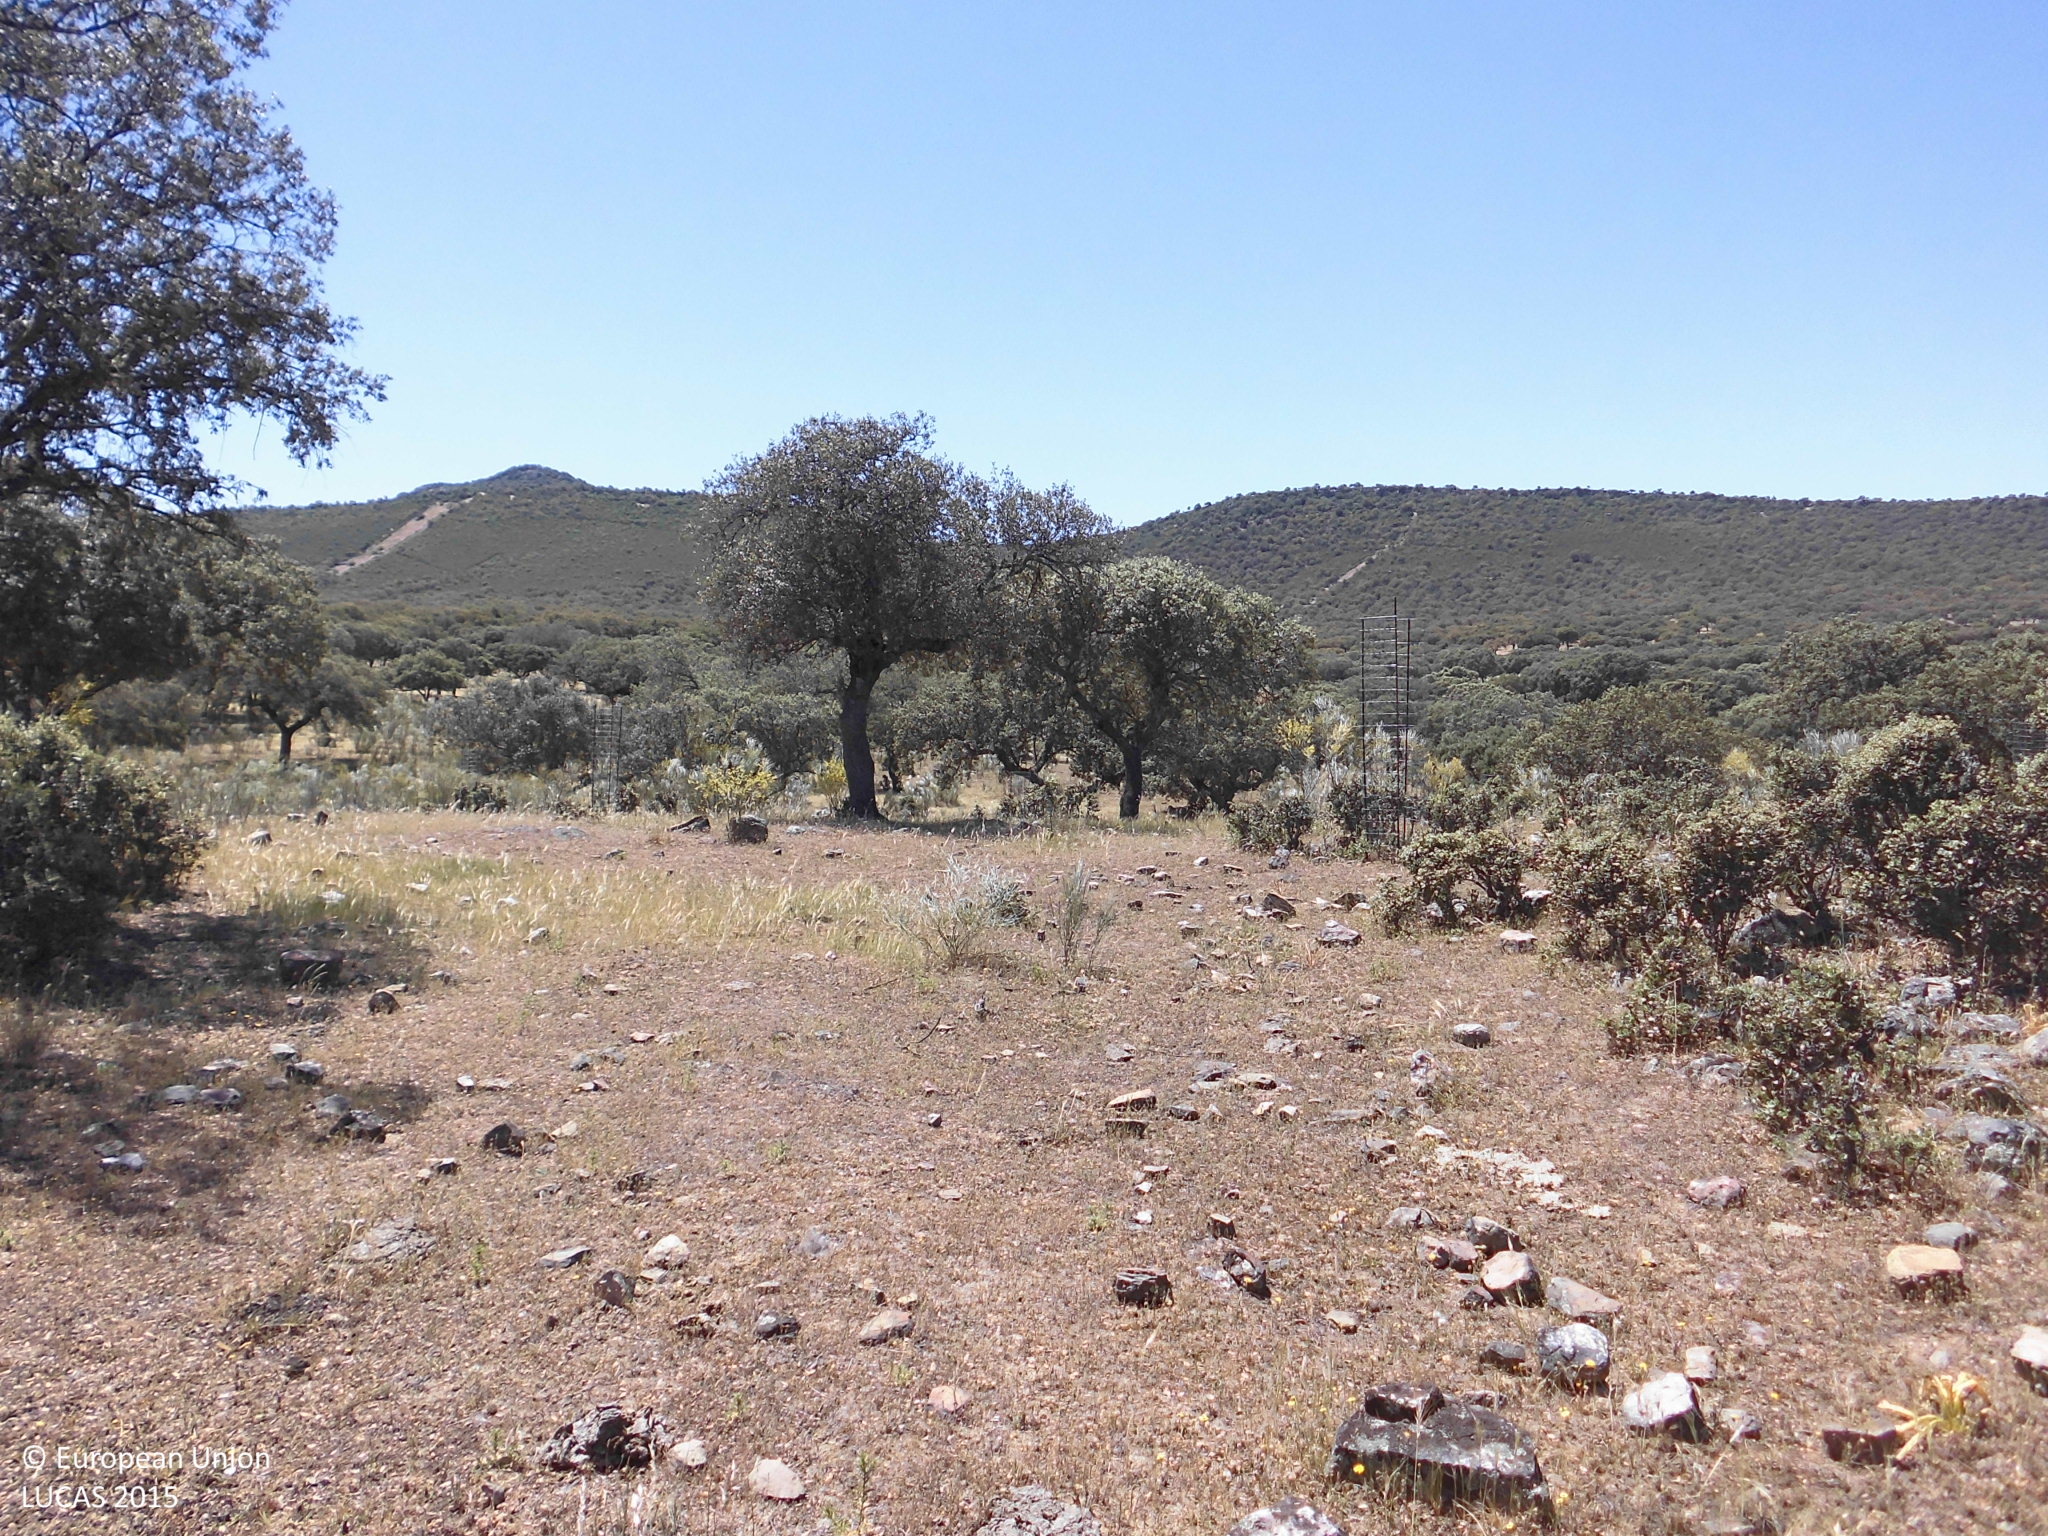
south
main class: Woodland
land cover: Broadleaved woodland
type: broadleaved evergreen forest
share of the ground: 25 - 50 %
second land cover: Grassland without tree/shrub cover
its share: > 75 %
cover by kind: herbaceous plants 50 %, broadleaved forest trees 35 %, shrubs 15 %
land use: Forestry
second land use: Agriculture (excluding fallow land and kitchen gardens)
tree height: > 5 m
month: May
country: ES
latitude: 39.4379
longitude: -6.9854
